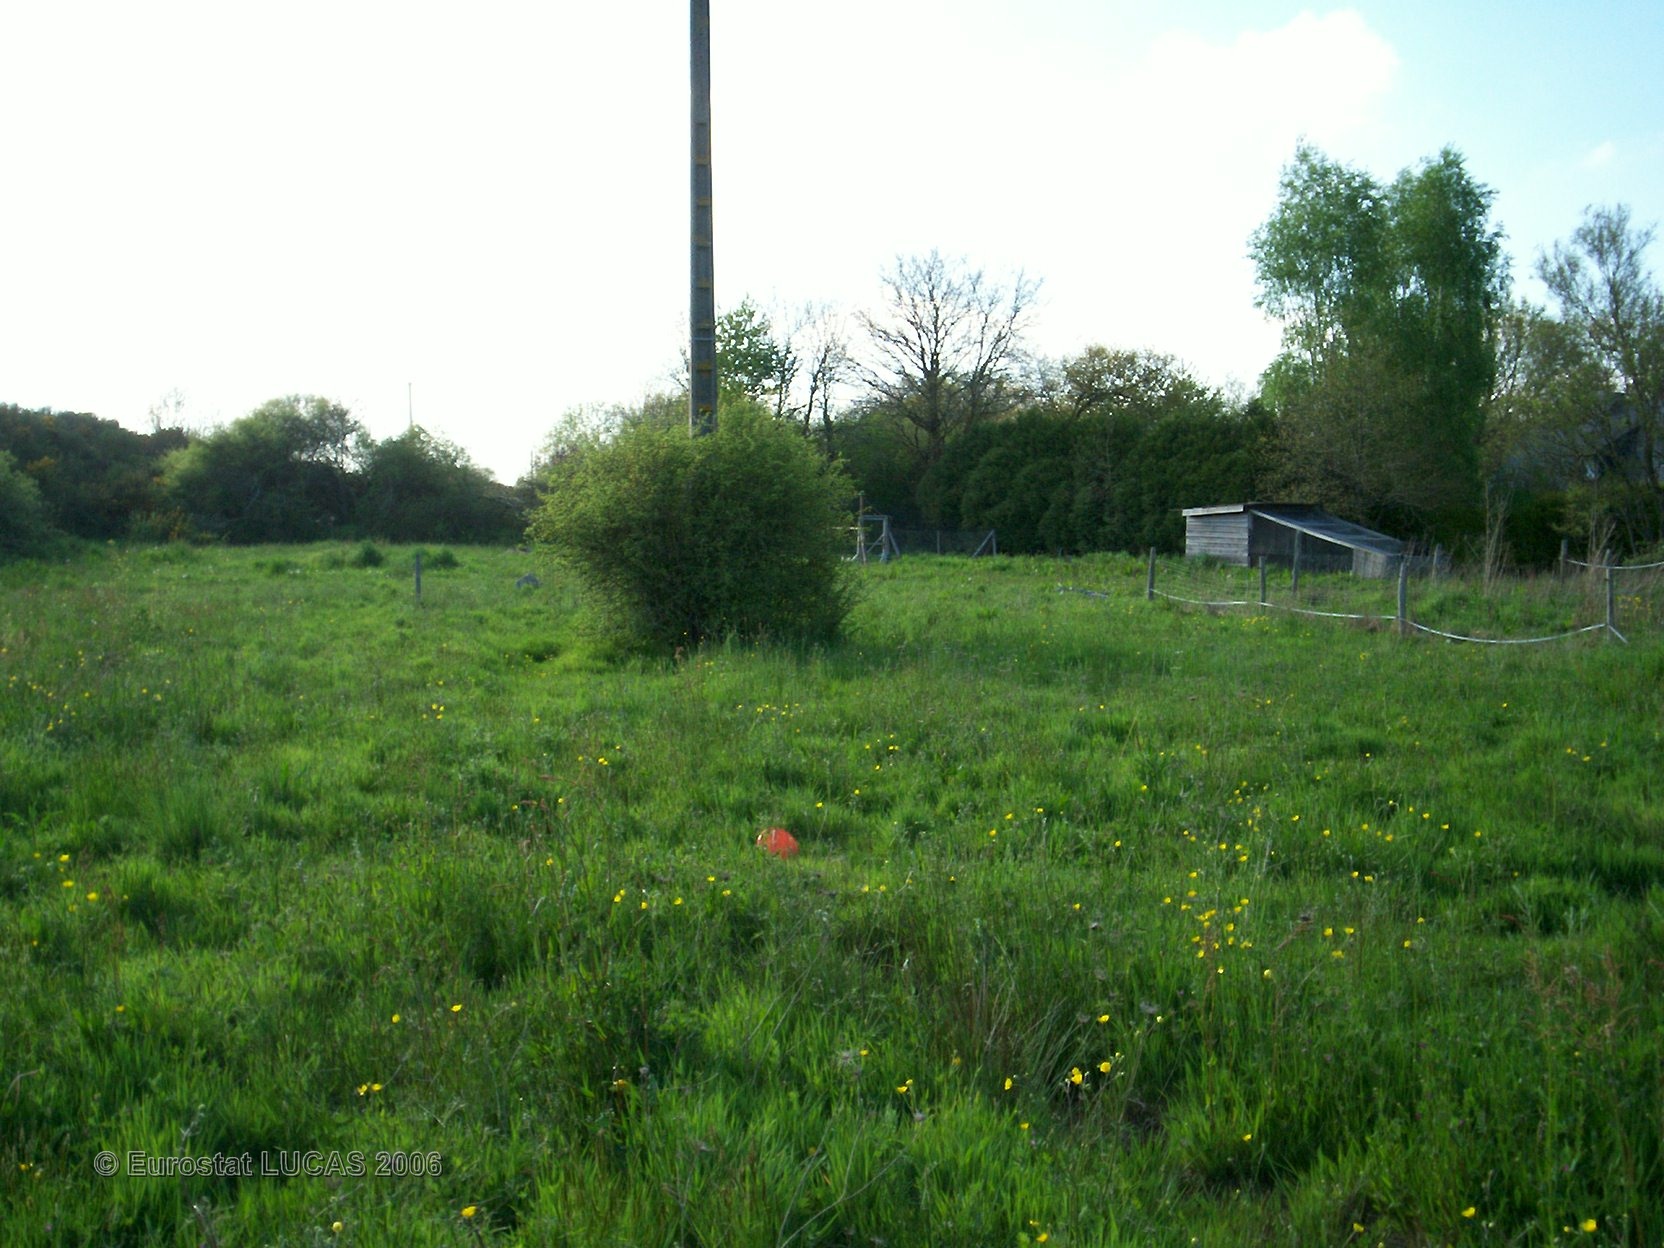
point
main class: Grassland
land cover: Grassland without tree/shrub cover
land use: Agriculture (excluding fallow land and kitchen gardens)
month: May
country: FR
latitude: 47.6061
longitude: -2.6029
